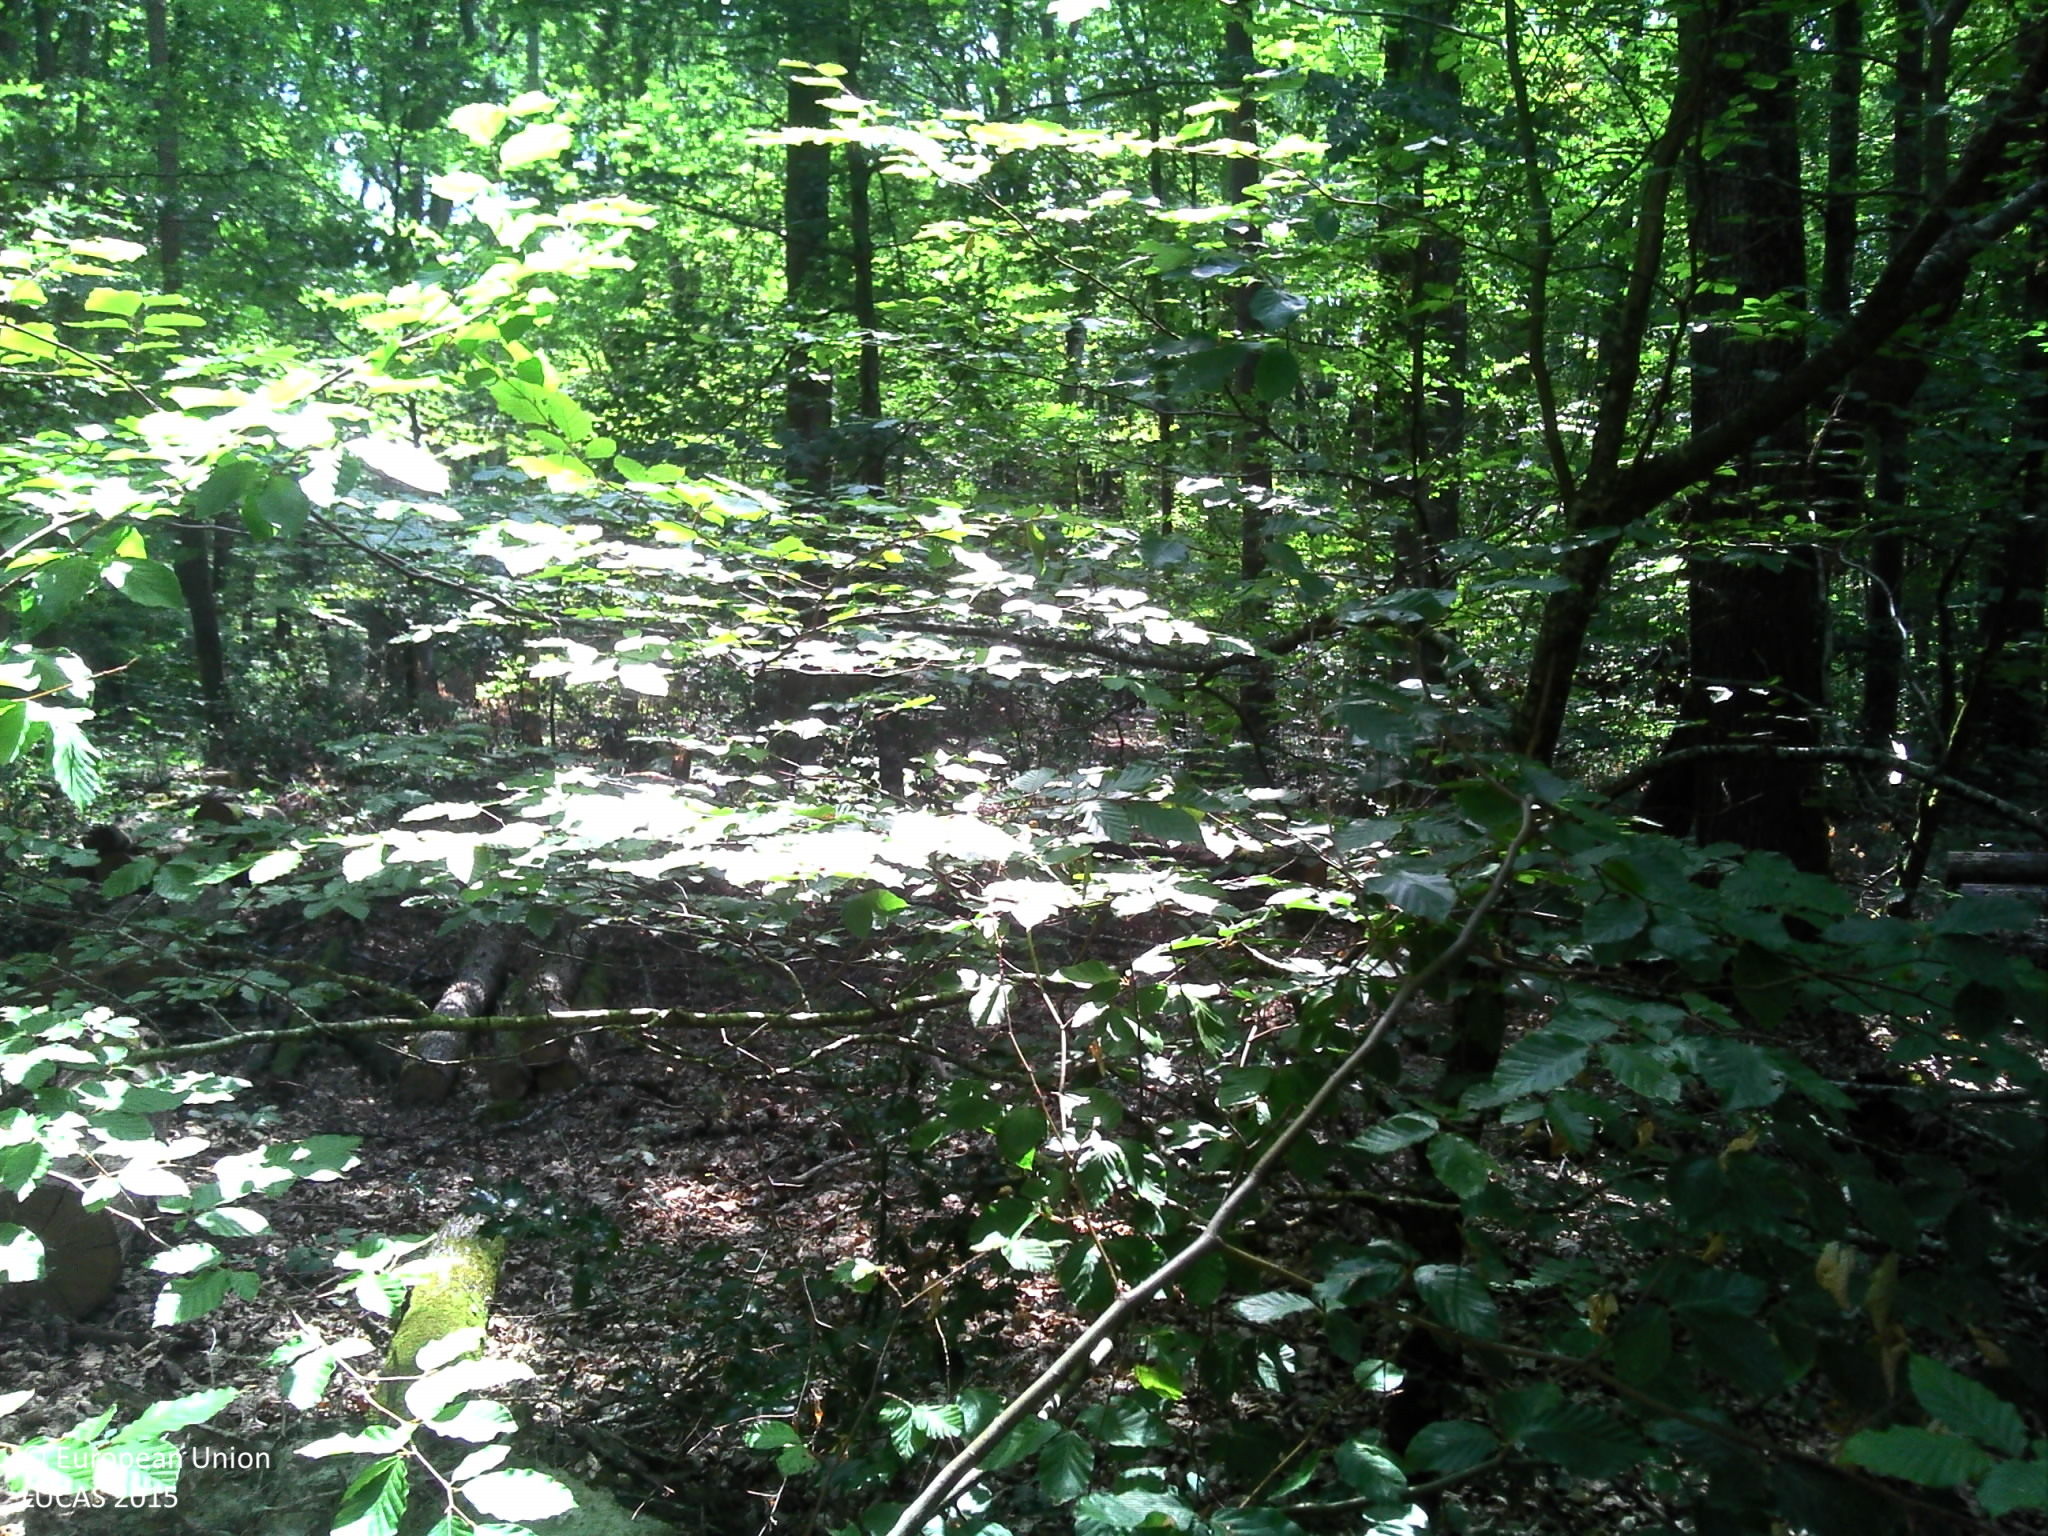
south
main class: Woodland
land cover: Broadleaved woodland
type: mesophytic deciduous forest
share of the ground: > 75 %
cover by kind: broadleaved forest trees 90 %, herbaceous plants 5 %, lichens and mosses 5 %
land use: Forestry
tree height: > 5 m
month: August
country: FR
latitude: 46.6811
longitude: 2.7134
